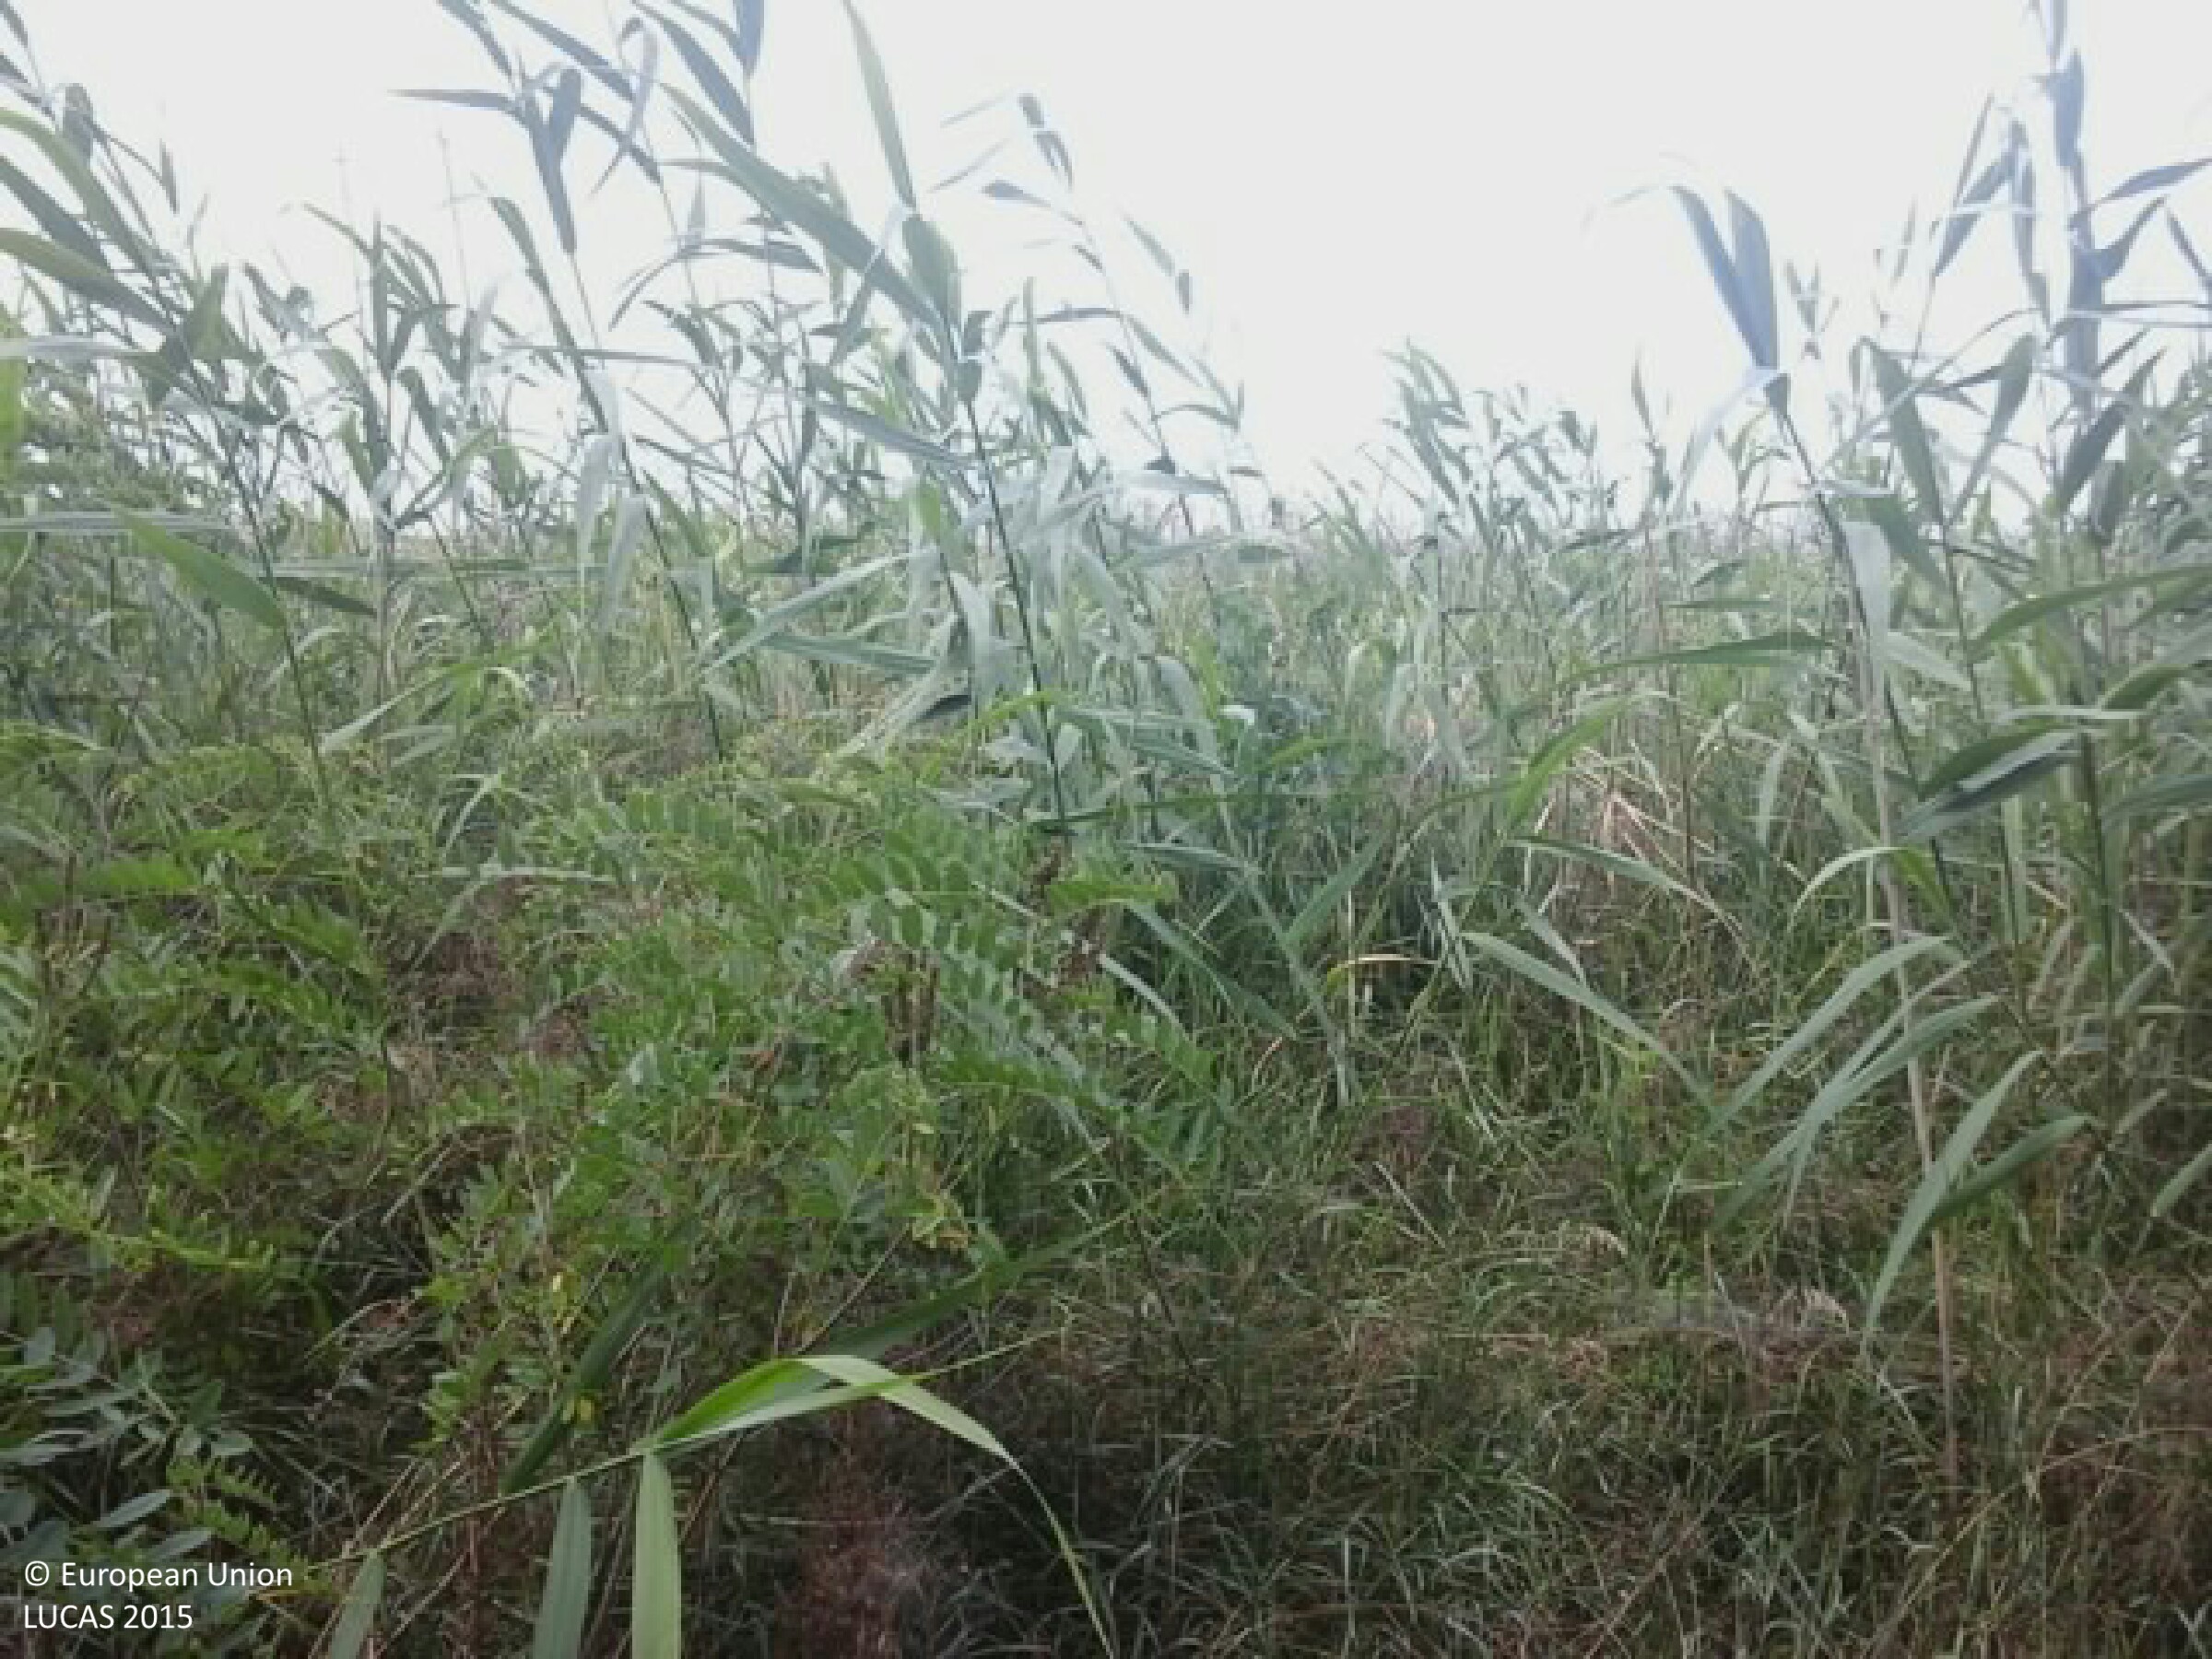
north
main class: Woodland
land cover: Broadleaved woodland
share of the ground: > 75 %
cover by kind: broadleaved forest trees 80 %, shrubs 20 %
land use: Semi-natural and natural areas not in use
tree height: > 5 m
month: June
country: HU
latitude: 46.5054
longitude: 20.3065
